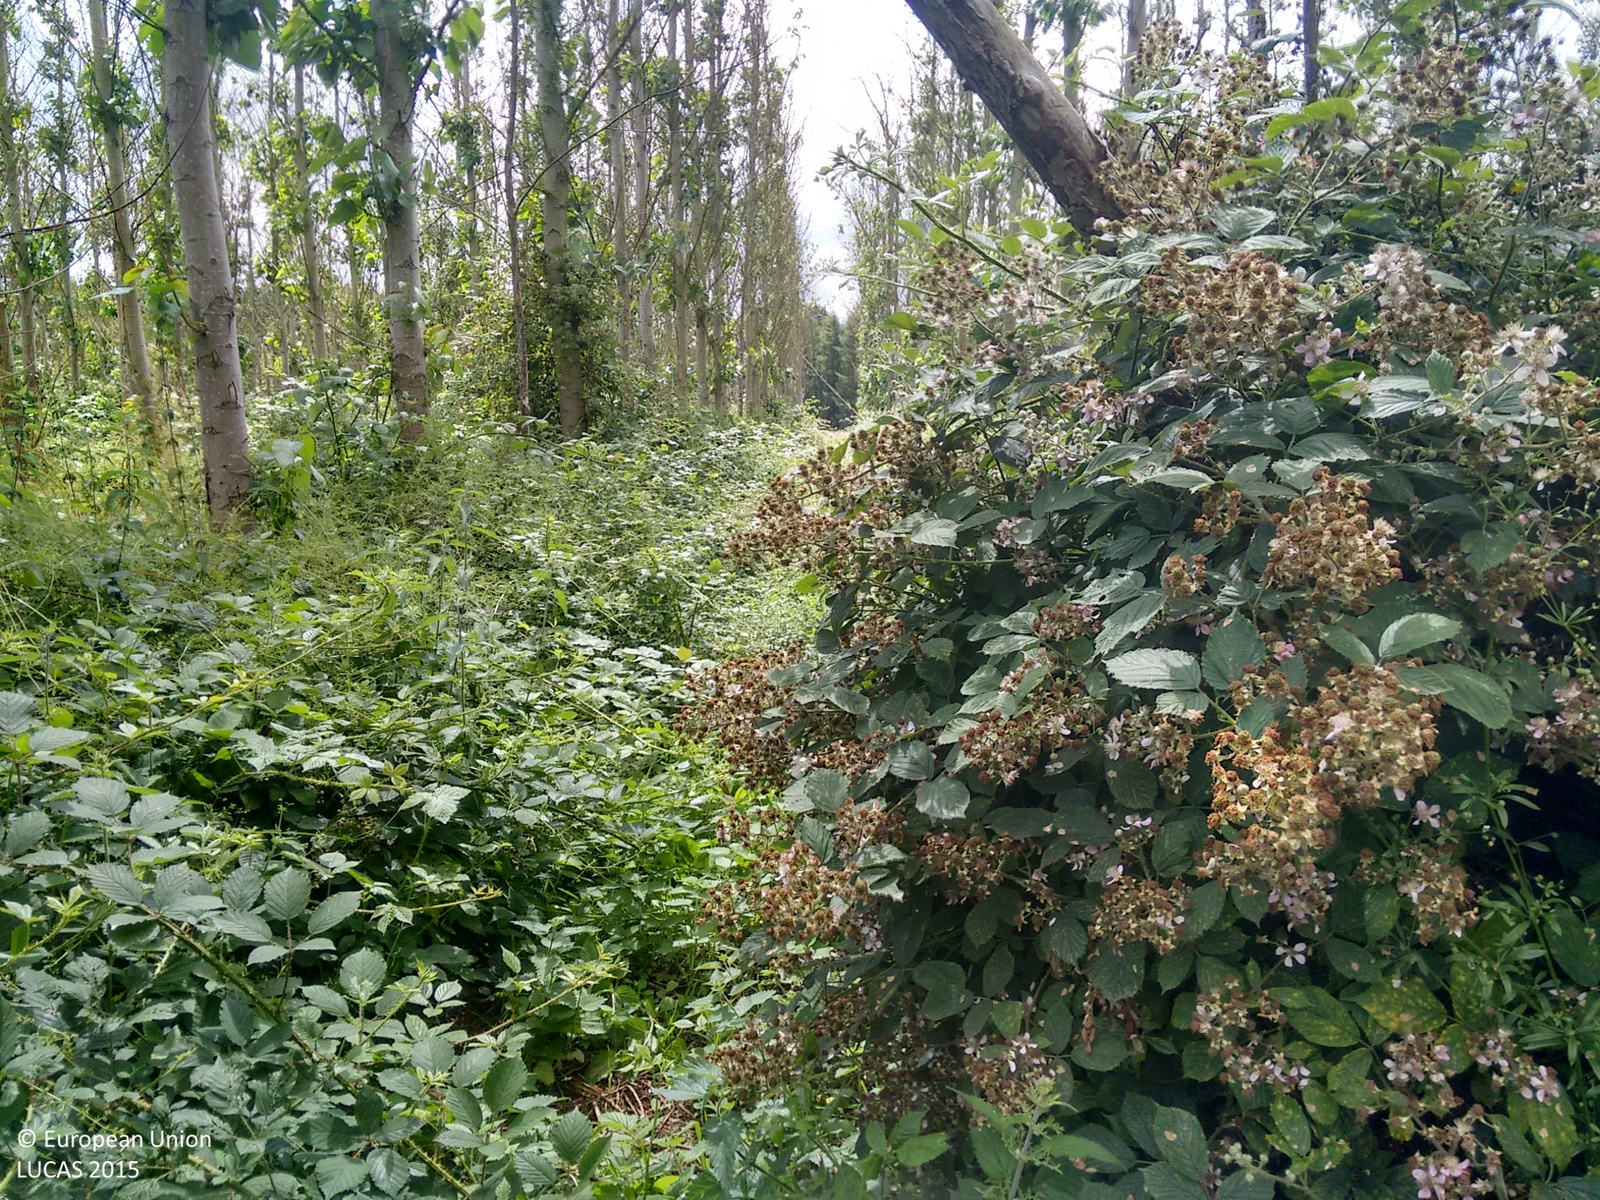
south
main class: Woodland
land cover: Broadleaved woodland
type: mesophytic deciduous forest
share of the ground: > 75 %
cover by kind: broadleaved forest trees 90 %, shrubs 10 %
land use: Forestry
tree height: > 5 m
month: July
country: GB
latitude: 52.6050
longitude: -1.7941
